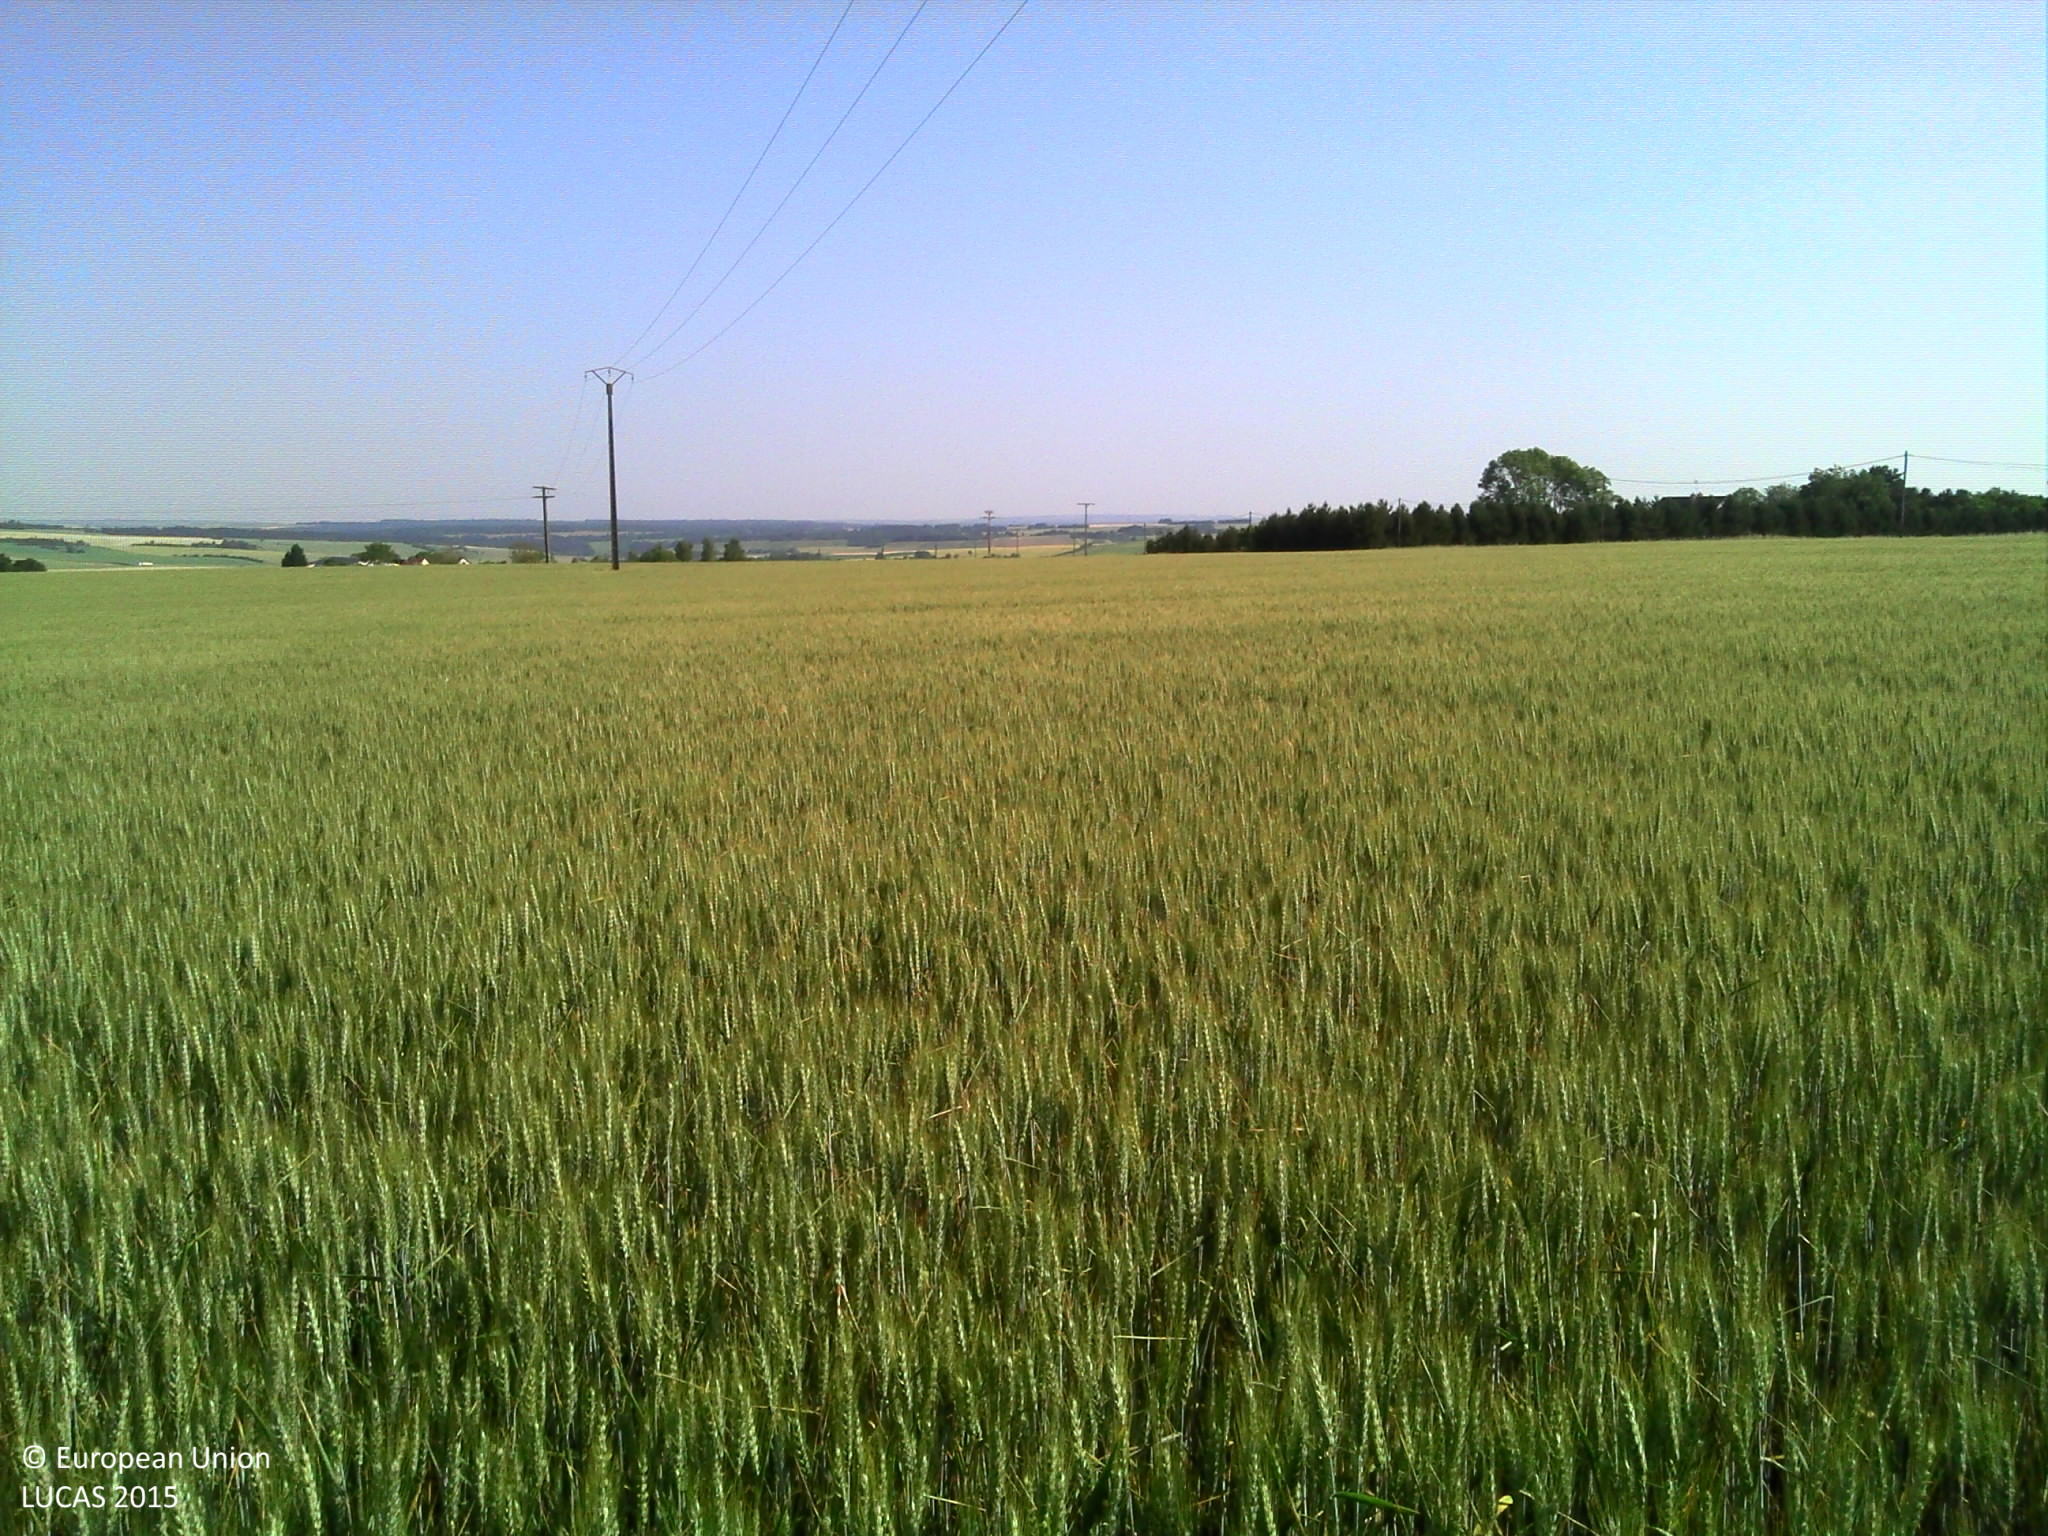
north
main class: Cropland
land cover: Common wheat
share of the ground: > 75 %
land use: Agriculture (excluding fallow land and kitchen gardens)
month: June
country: FR
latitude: 47.6015
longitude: 3.8655
